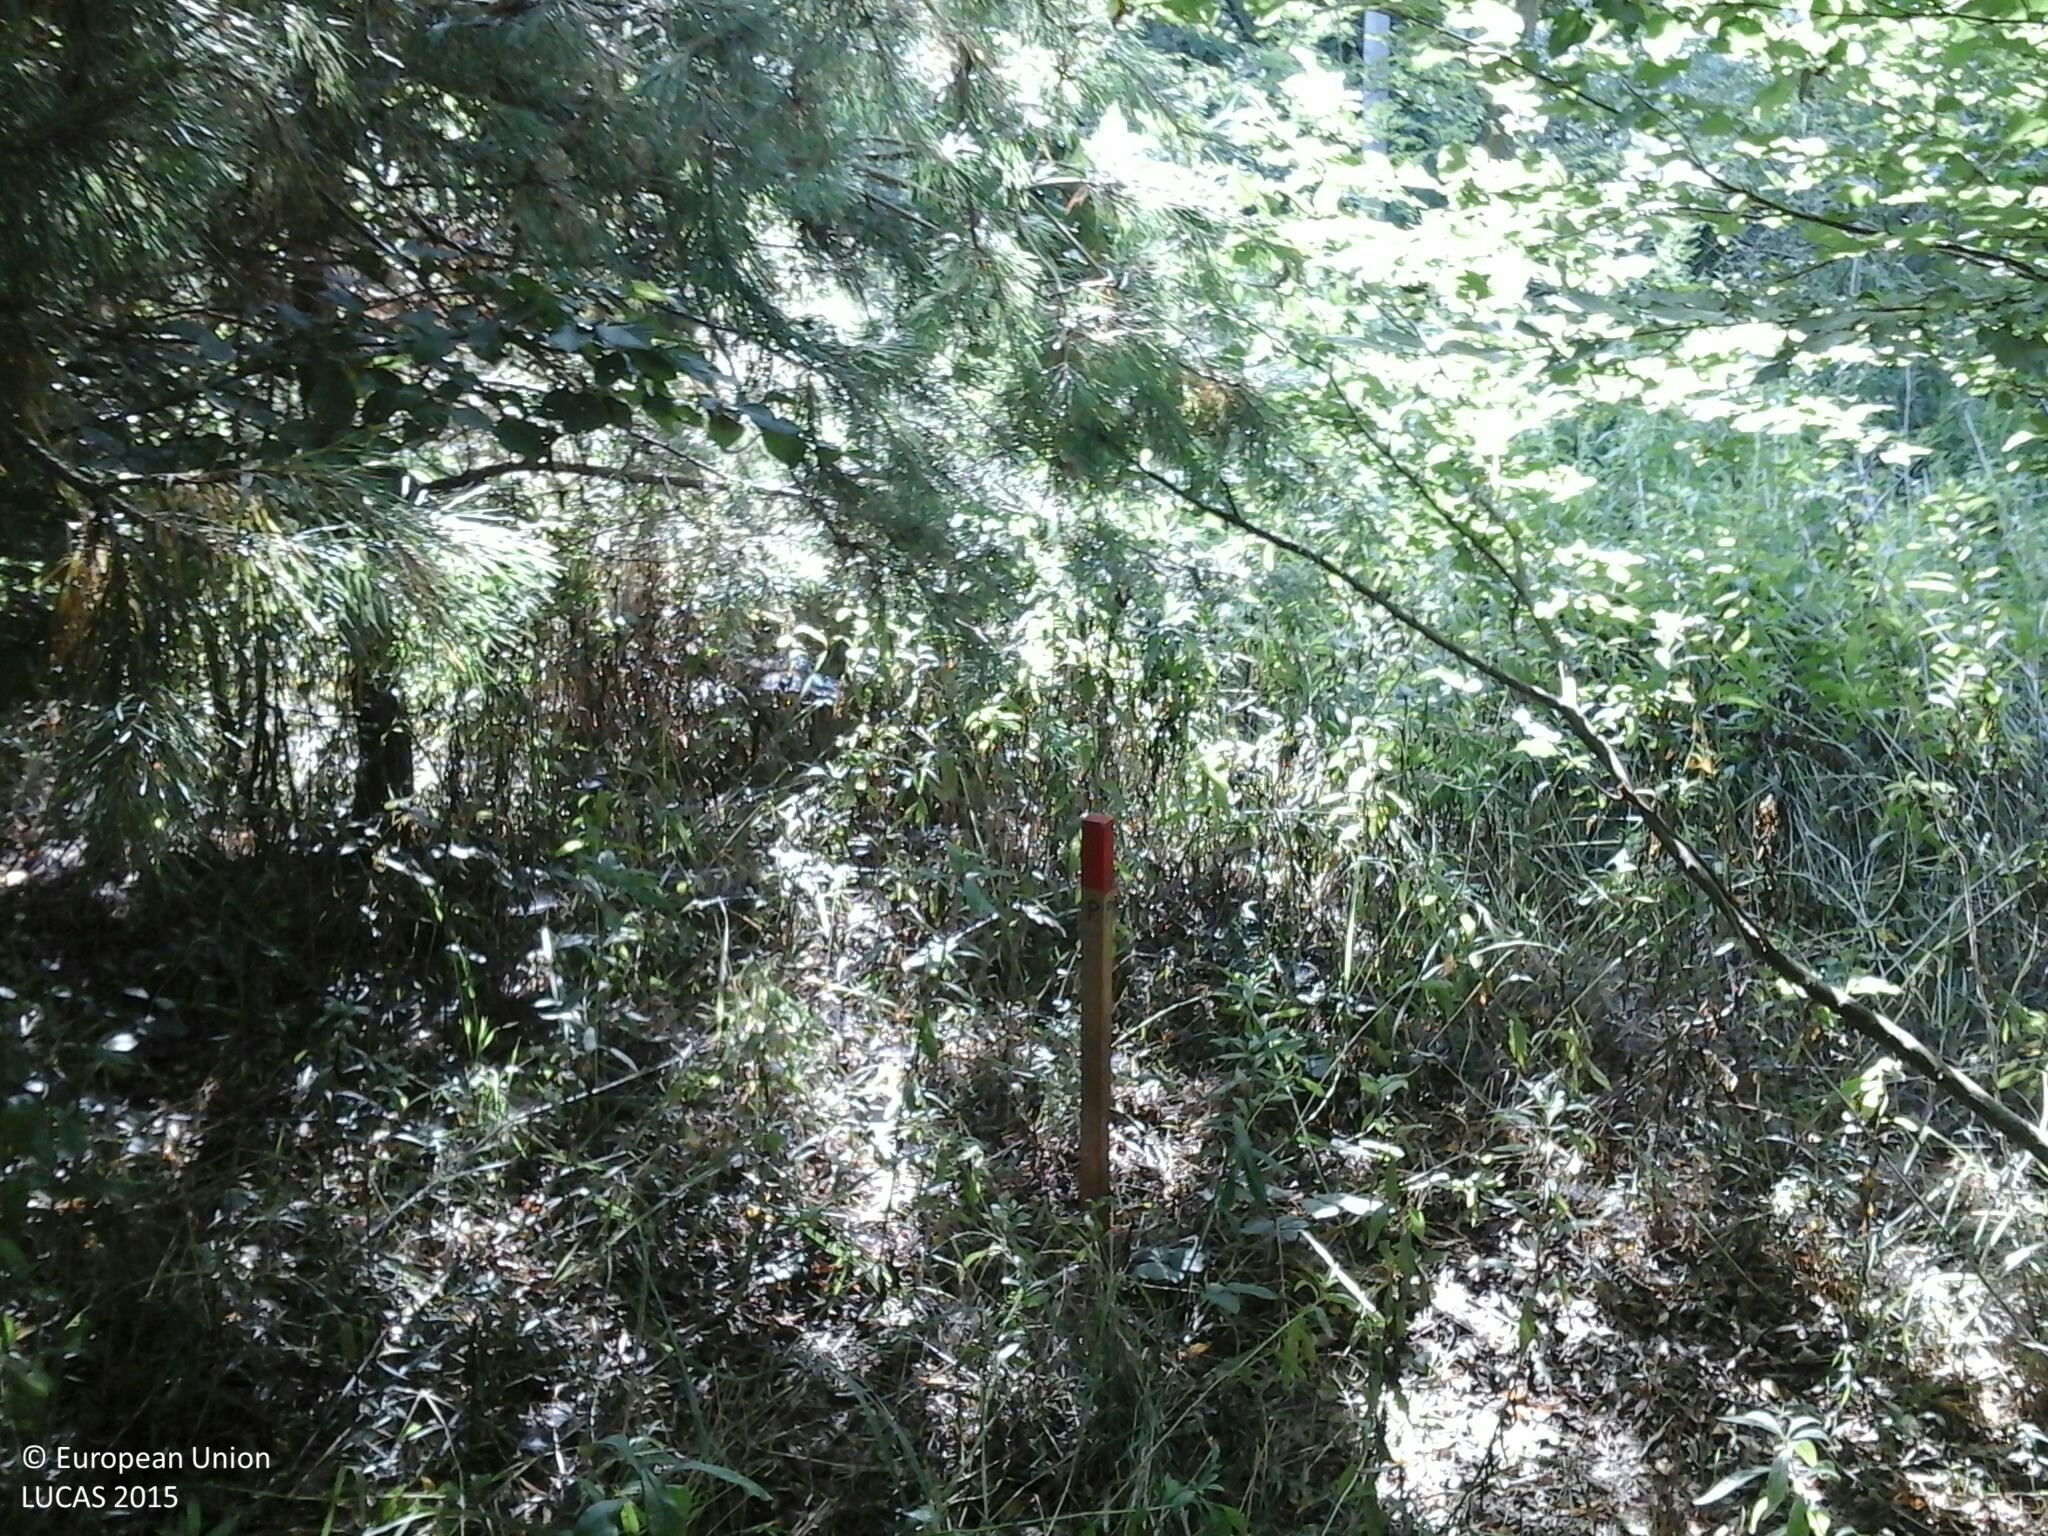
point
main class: Woodland
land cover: Pine dominated mixed woodland
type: hemiboreal forest and nemoral coniferous forest and mixed broadleaved-coniferous forest
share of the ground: > 75 %
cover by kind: coniferous forest trees 50 %, broadleaved forest trees 30 %, shrubs 10 %, herbaceous plants 10 %
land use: Semi-natural and natural areas not in use
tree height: > 5 m
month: August
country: HU
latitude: 46.9204
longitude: 16.6606
